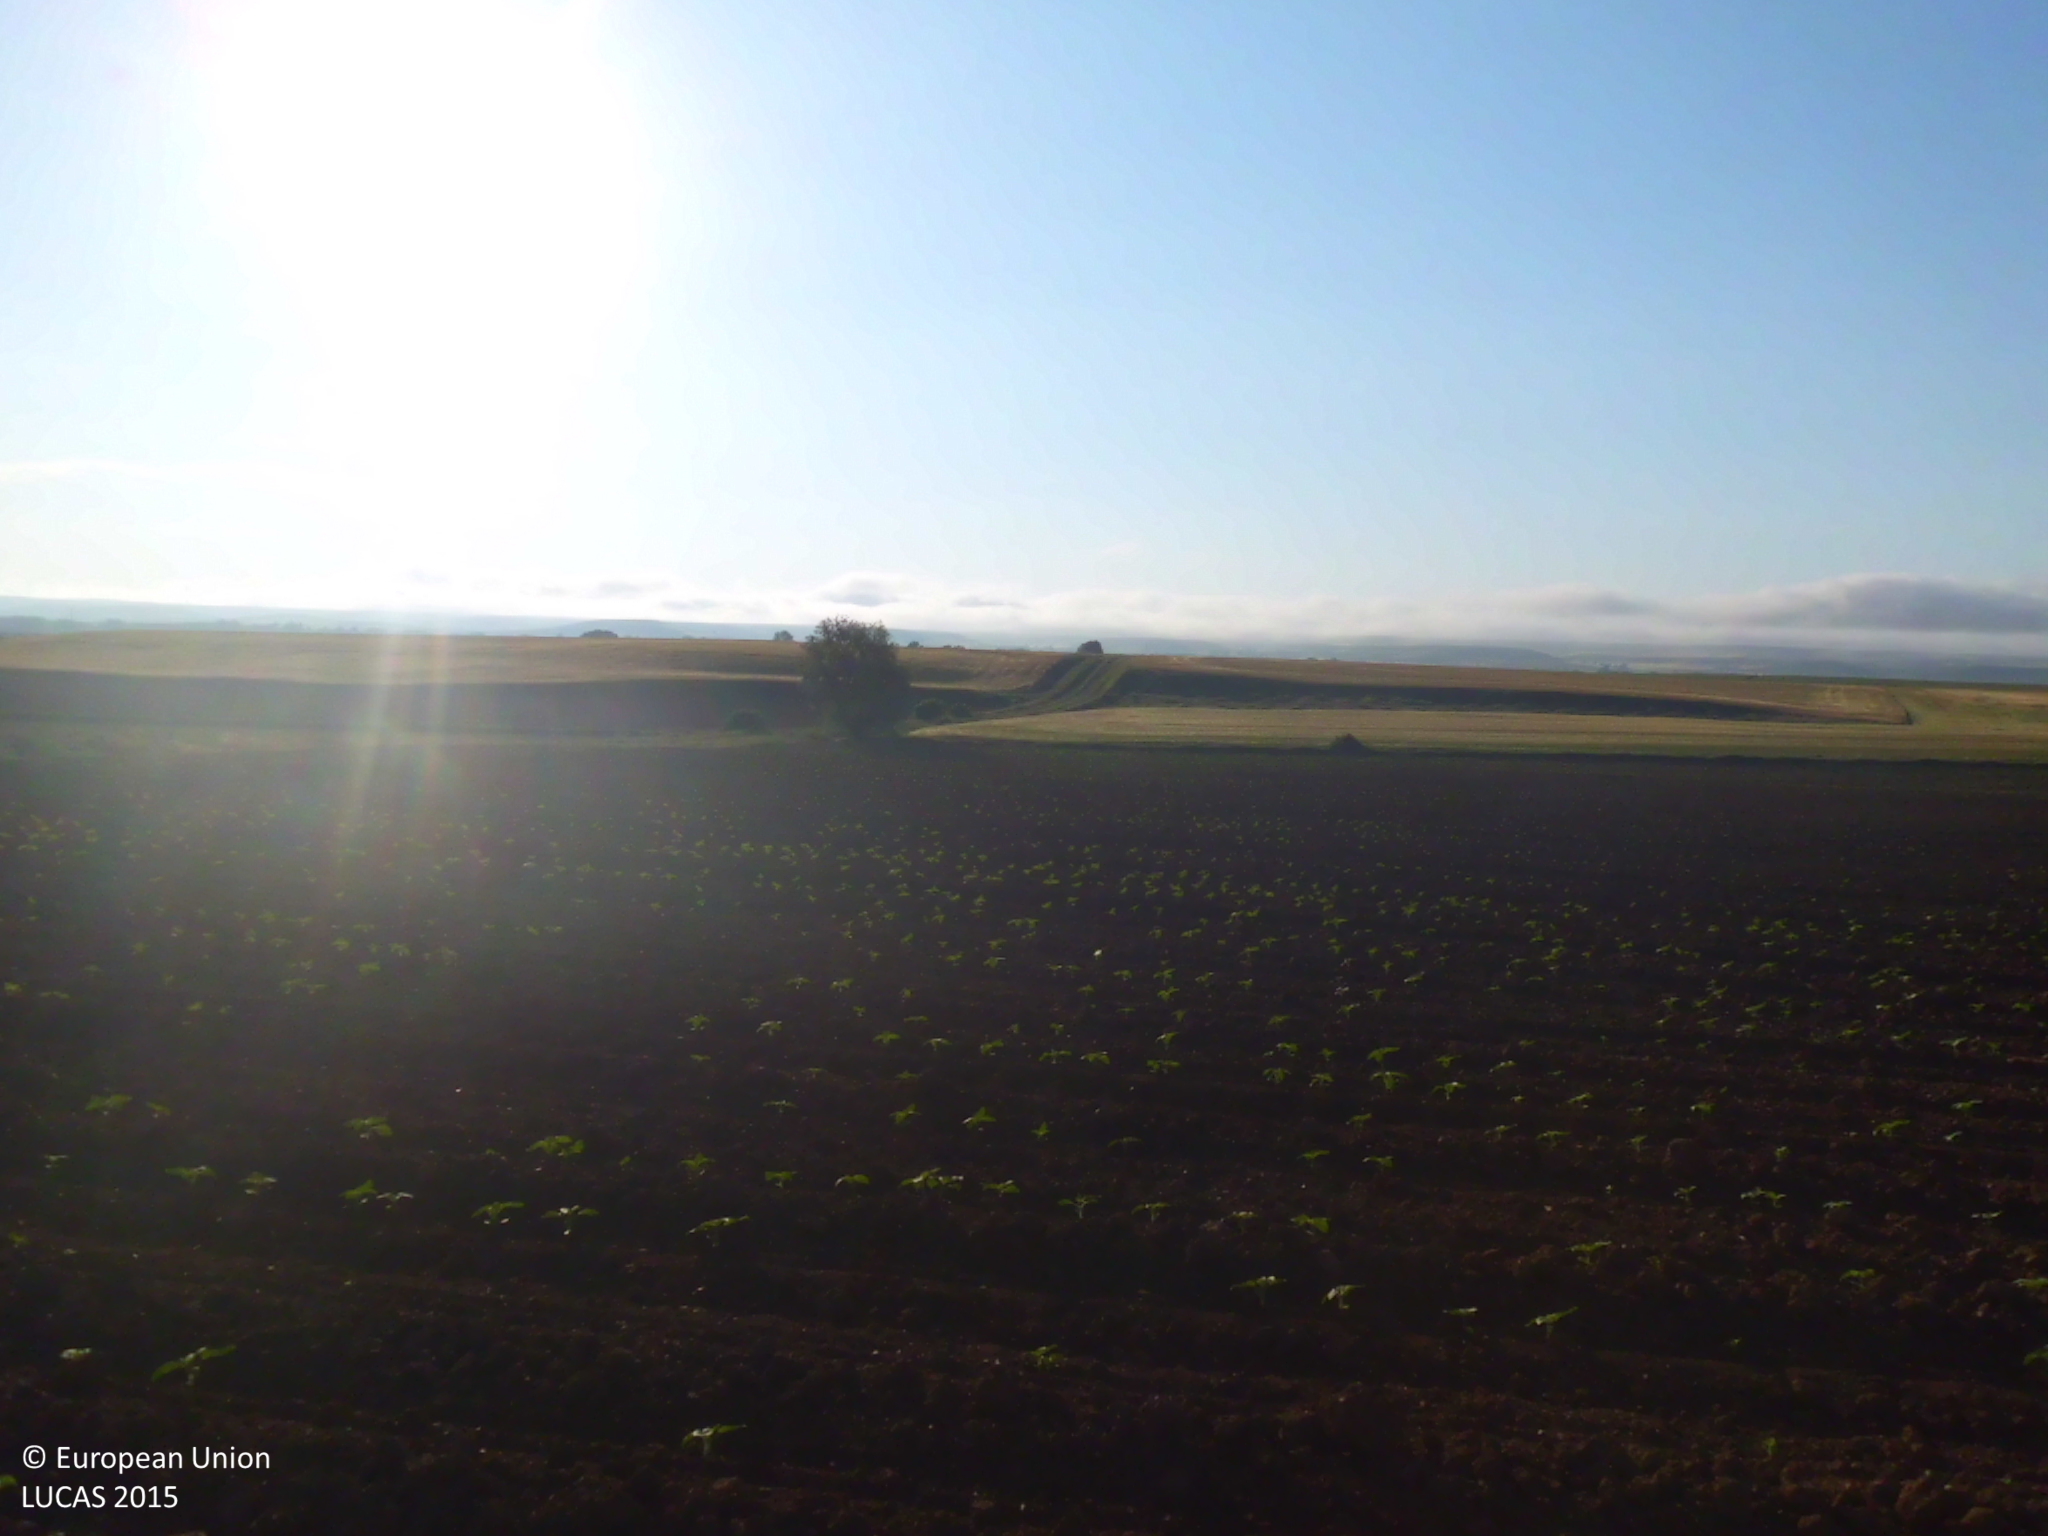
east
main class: Cropland
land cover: Sunflower
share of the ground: < 10 %
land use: Agriculture (excluding fallow land and kitchen gardens)
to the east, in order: Sunflower; Ditches and canals; Barley; Grass margins; Tracks; Grass margins; Sunflower; Grass margins; Barley
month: June
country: ES
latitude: 42.4931
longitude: -4.0478
